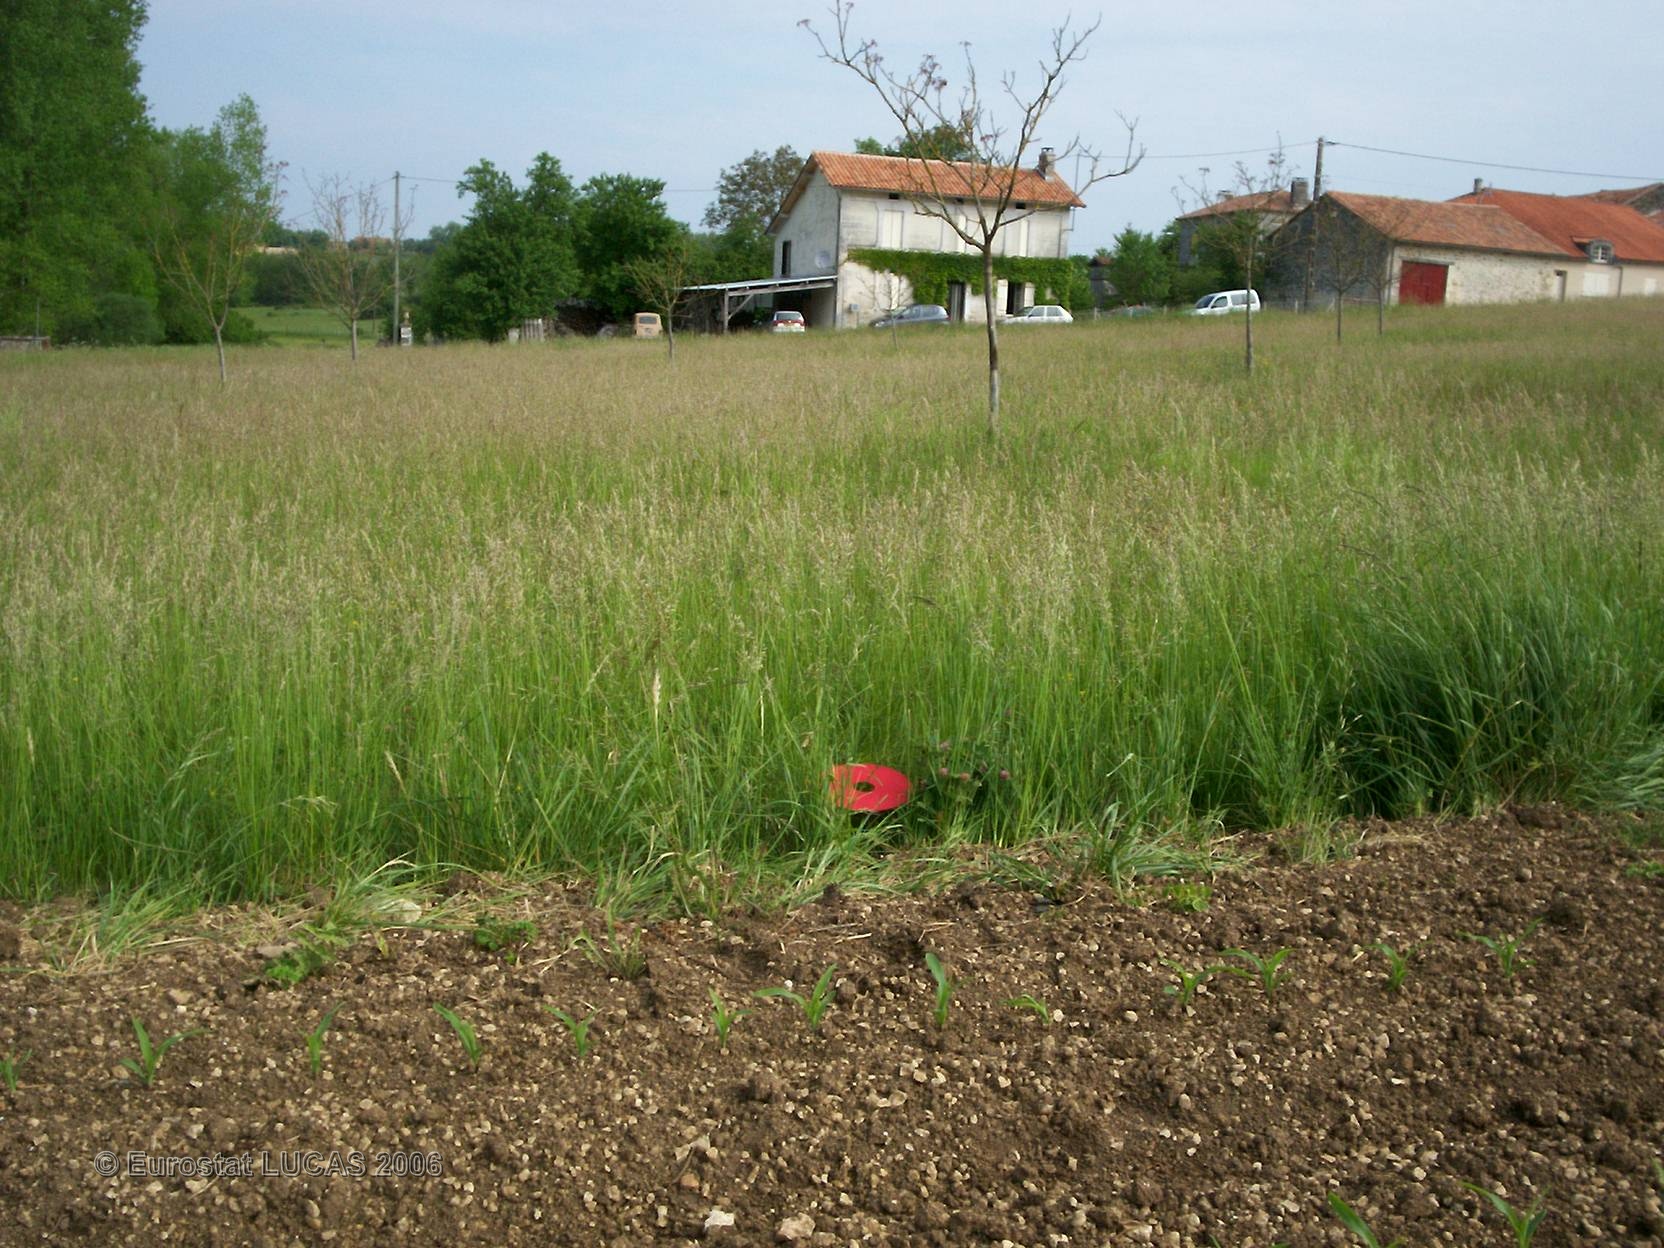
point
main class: Grassland
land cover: Grassland with sparse tree/shrub cover
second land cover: Nuts trees
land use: Agriculture (excluding fallow land and kitchen gardens)
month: May
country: FR
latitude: 45.4951
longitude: 0.5306
